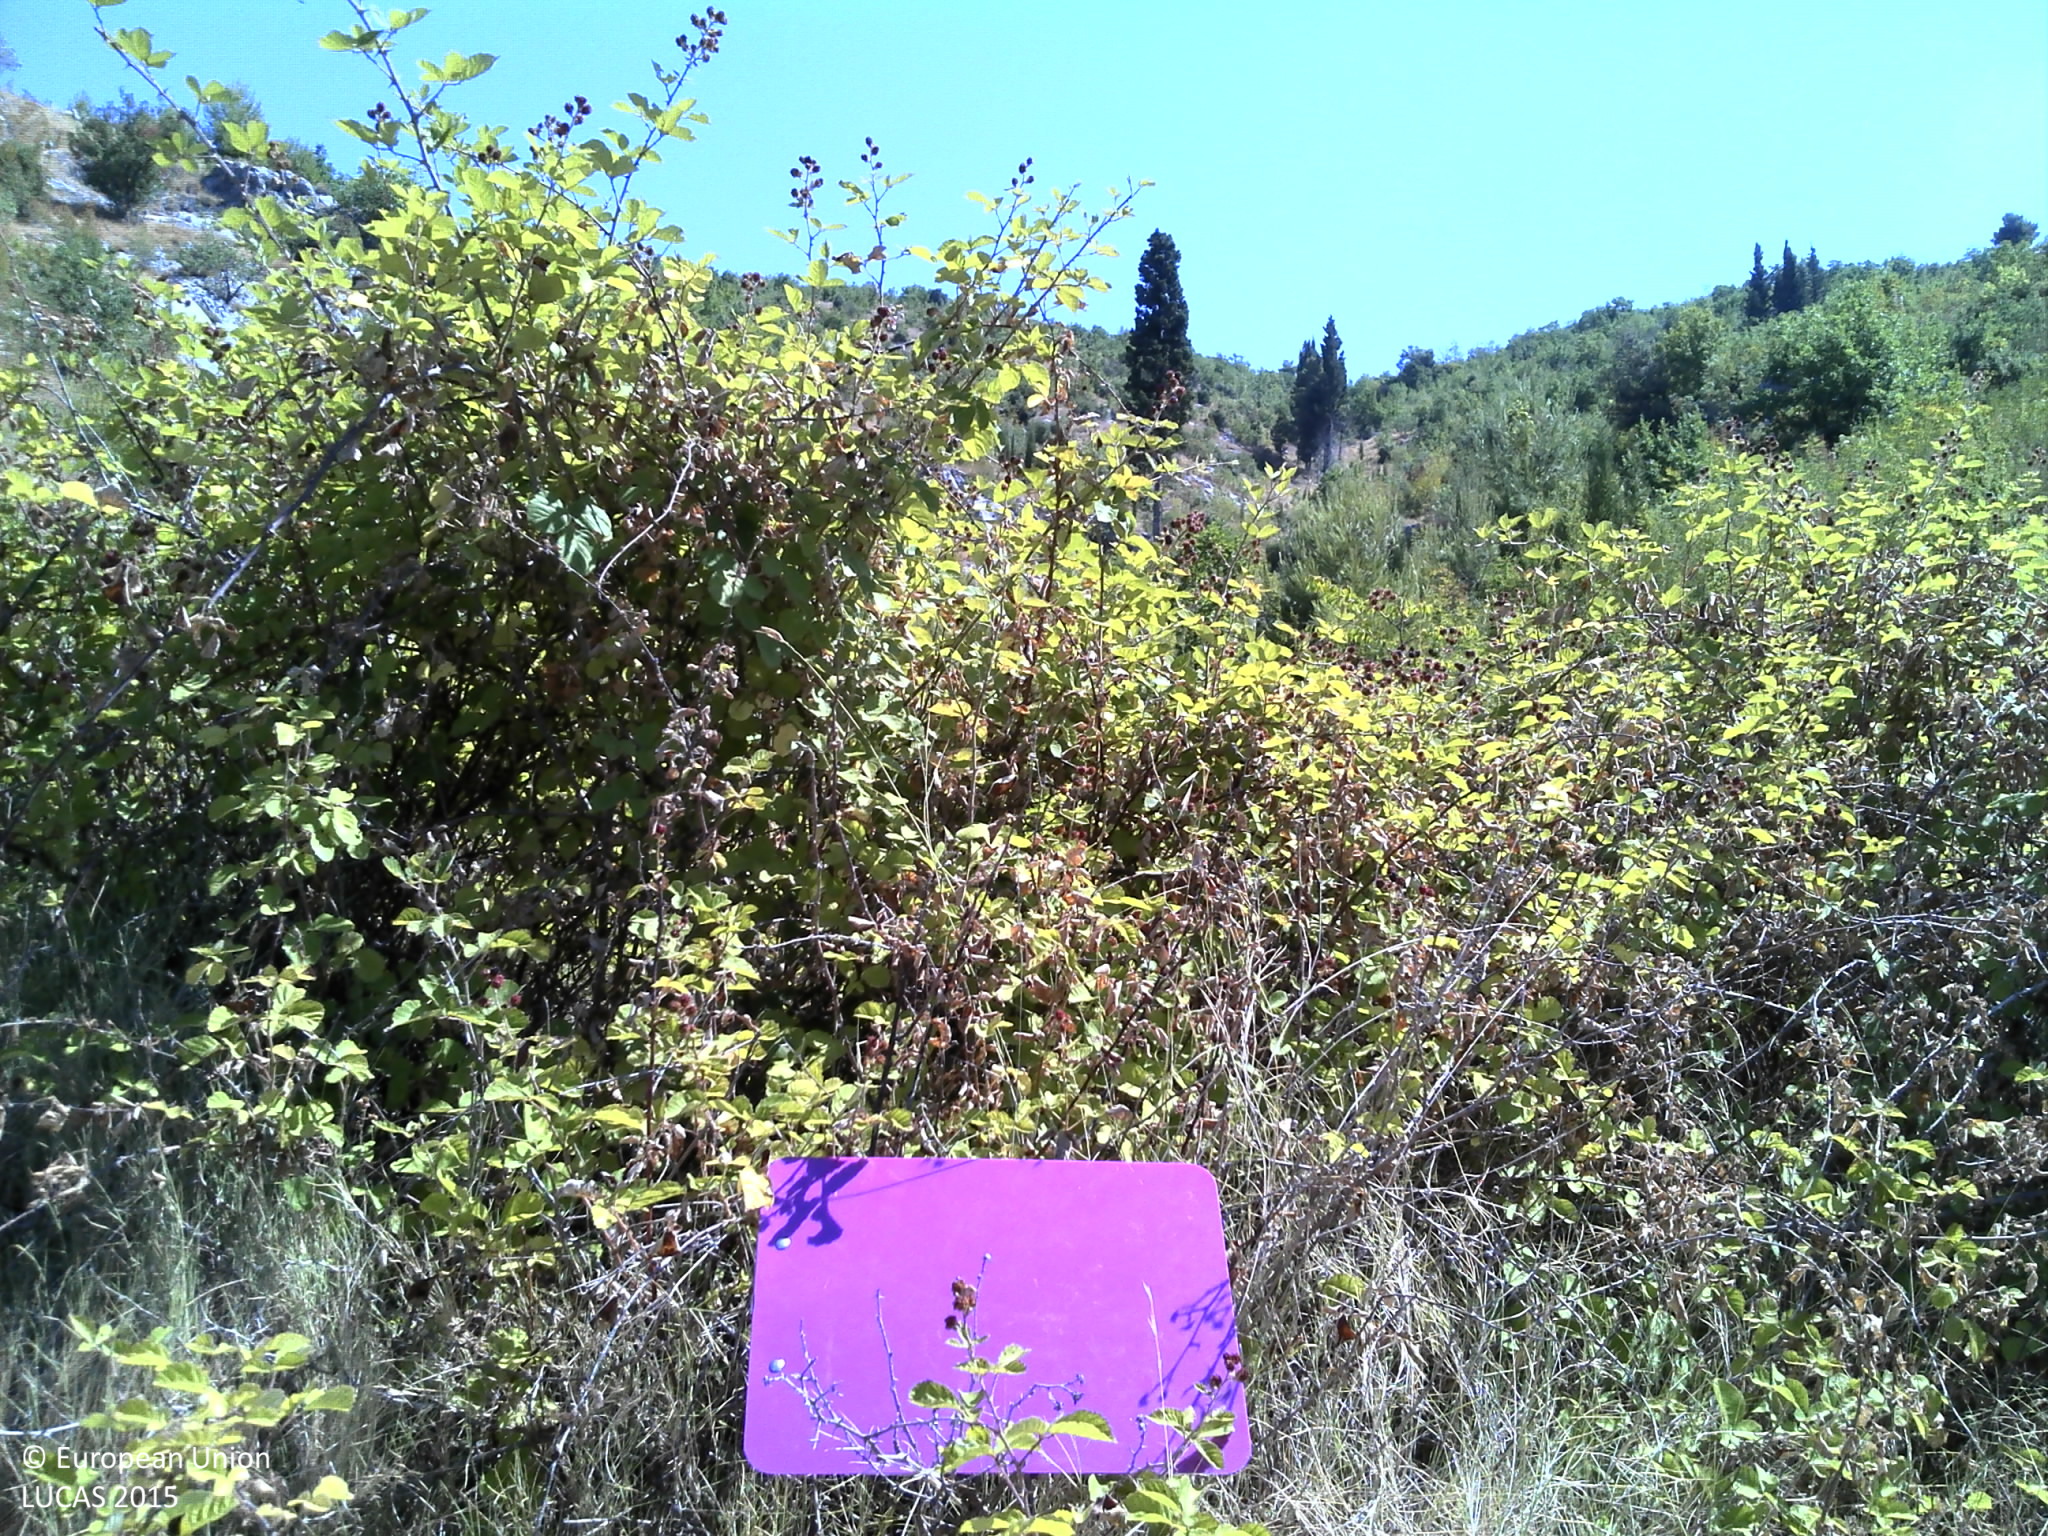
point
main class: Shrubland
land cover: Shrubland with sparse tree cover
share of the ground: > 75 %
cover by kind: shrubs 50 %, unconsolidated bare surface 30 %, herbaceous plants 15 %, coniferous forest trees 5 %
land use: Semi-natural and natural areas not in use
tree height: < 5 m
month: July
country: HR
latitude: 43.0343
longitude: 17.6620
